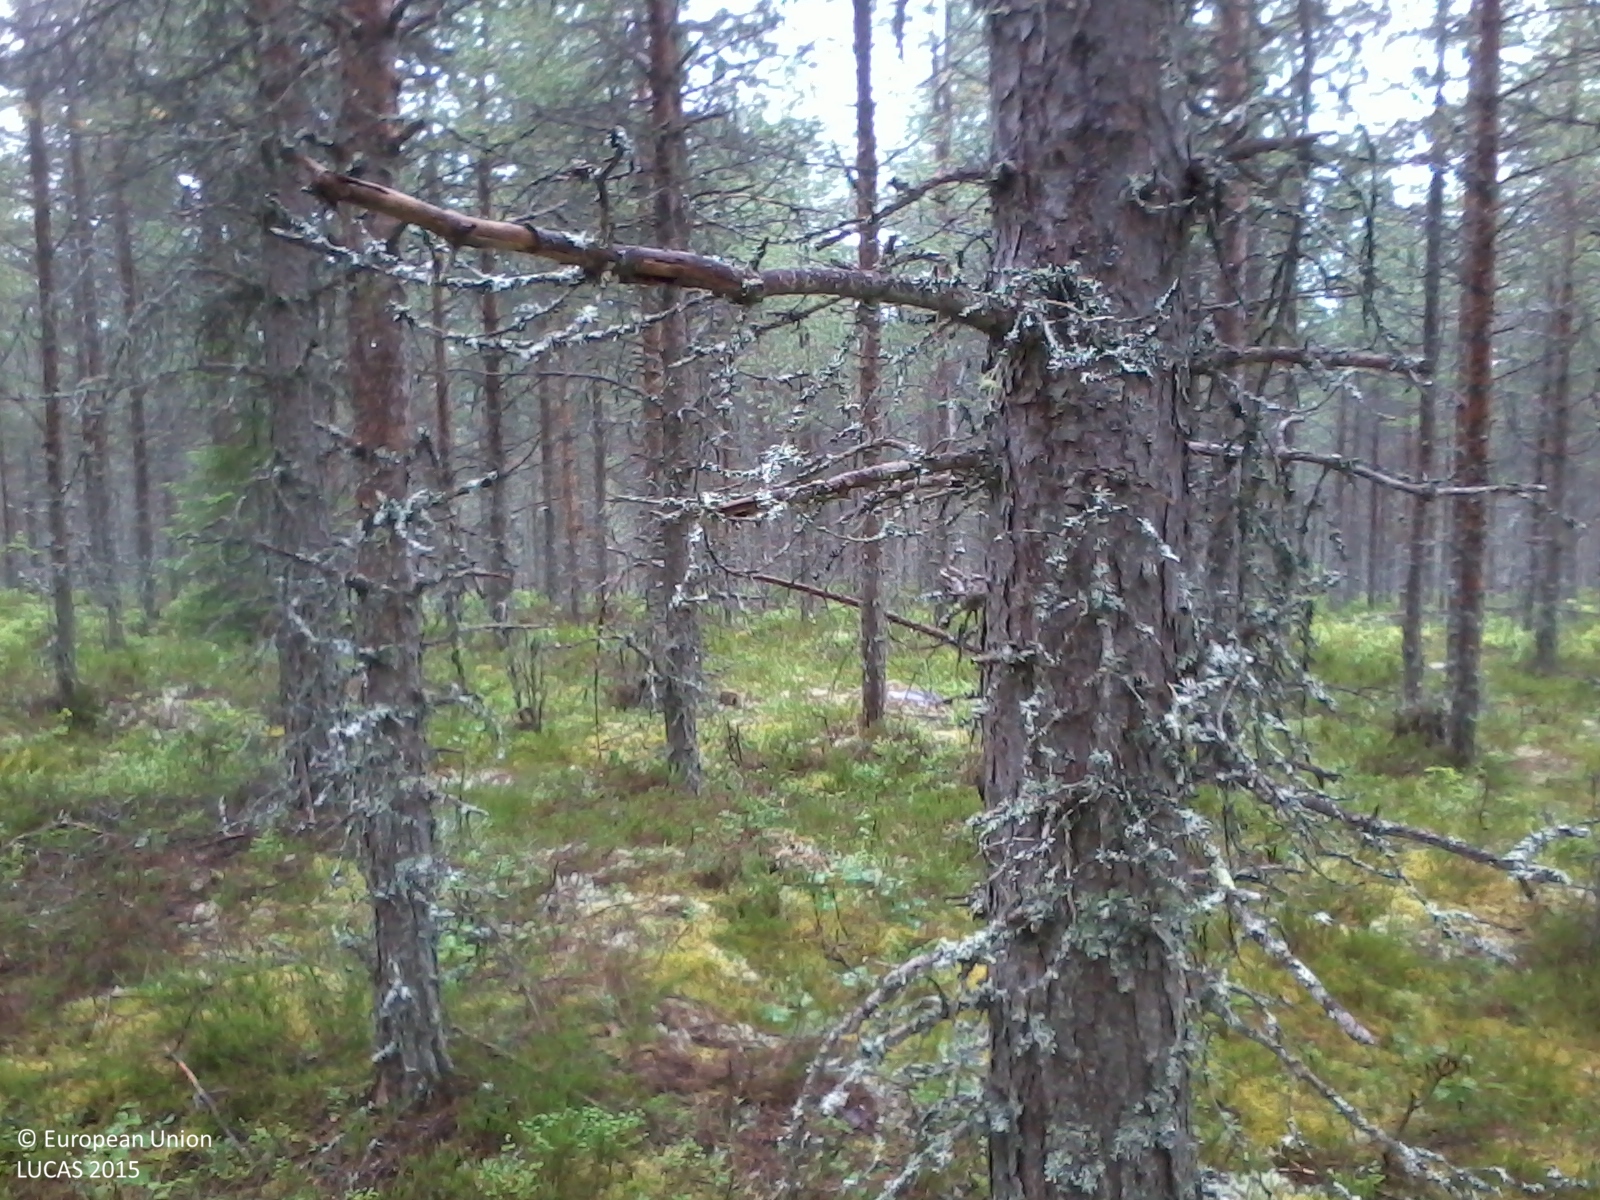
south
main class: Woodland
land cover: Pine dominated coniferous woodland
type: boreal forest
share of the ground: > 75 %
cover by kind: coniferous forest trees 75 %, lichens and mosses 15 %, shrubs 10 %
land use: Forestry
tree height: > 5 m
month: August
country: SE
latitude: 62.8879
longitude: 16.9201
